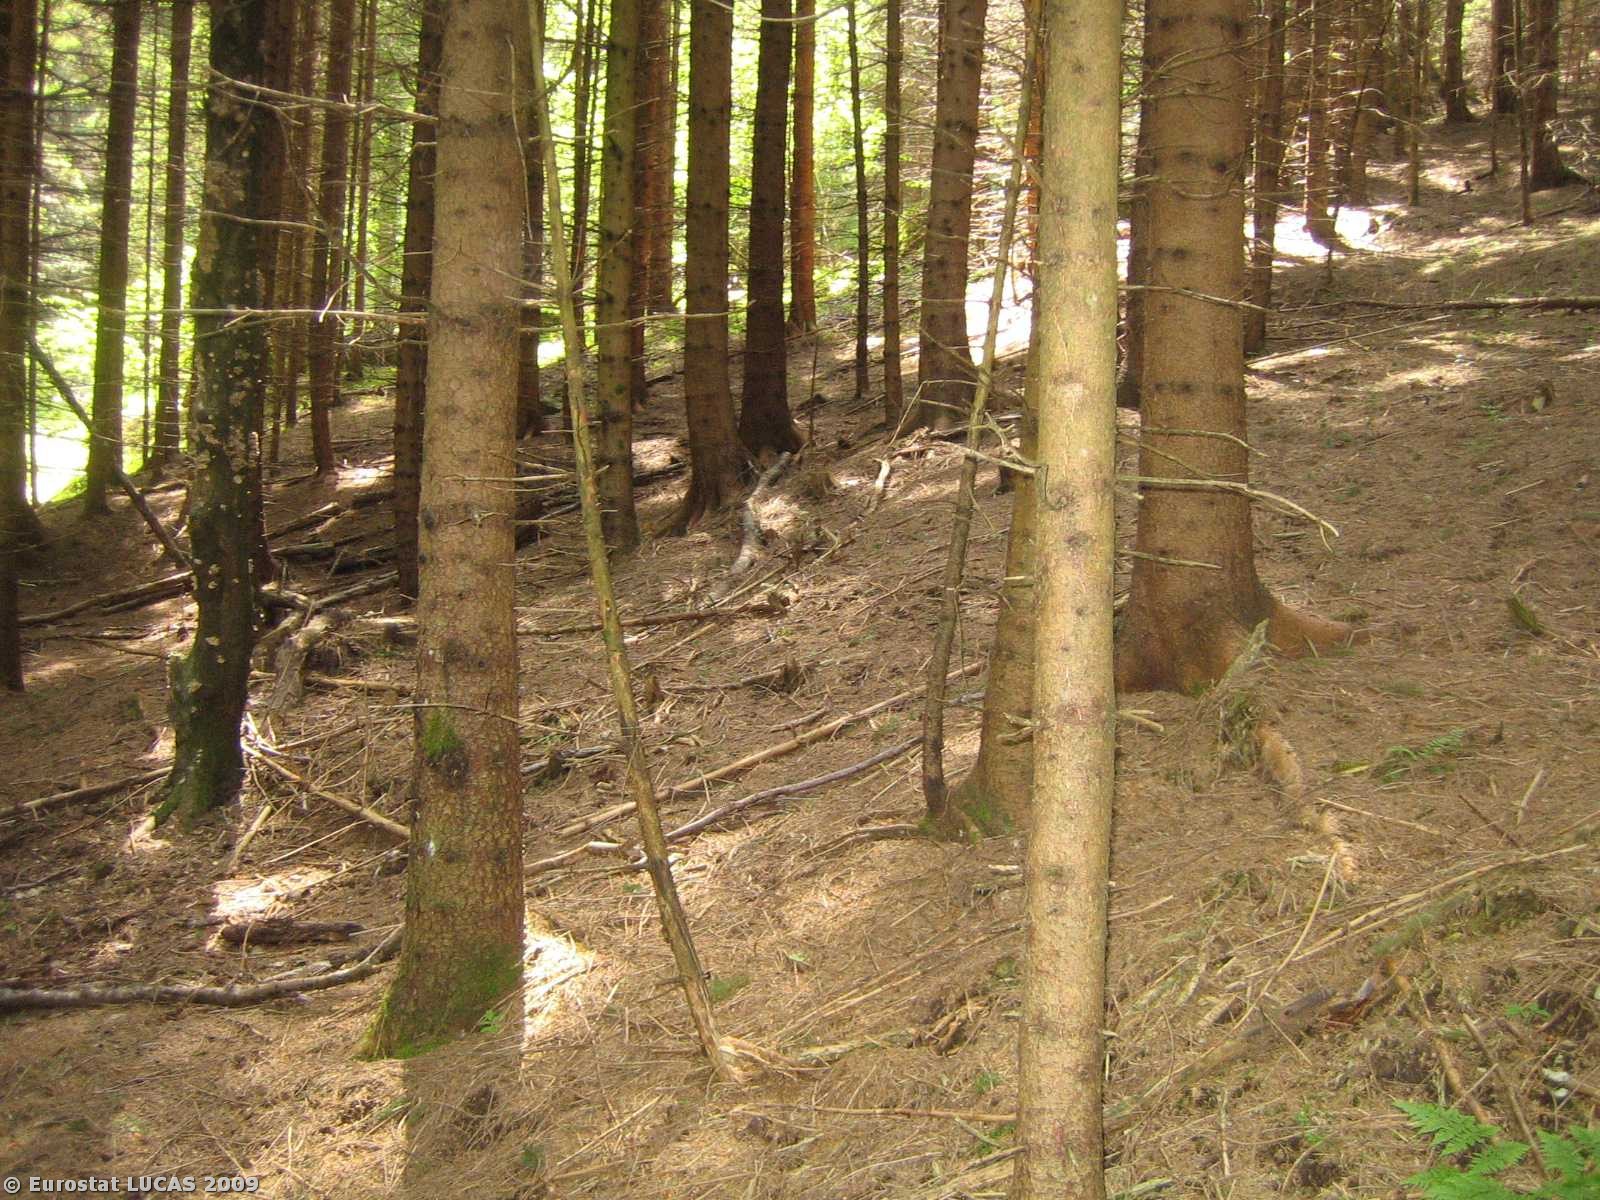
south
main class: Woodland
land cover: Coniferous woodland
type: alpine coniferous forest
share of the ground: > 75 %
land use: Forestry
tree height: > 5 m
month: June
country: IT
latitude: 46.1756
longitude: 11.6947
